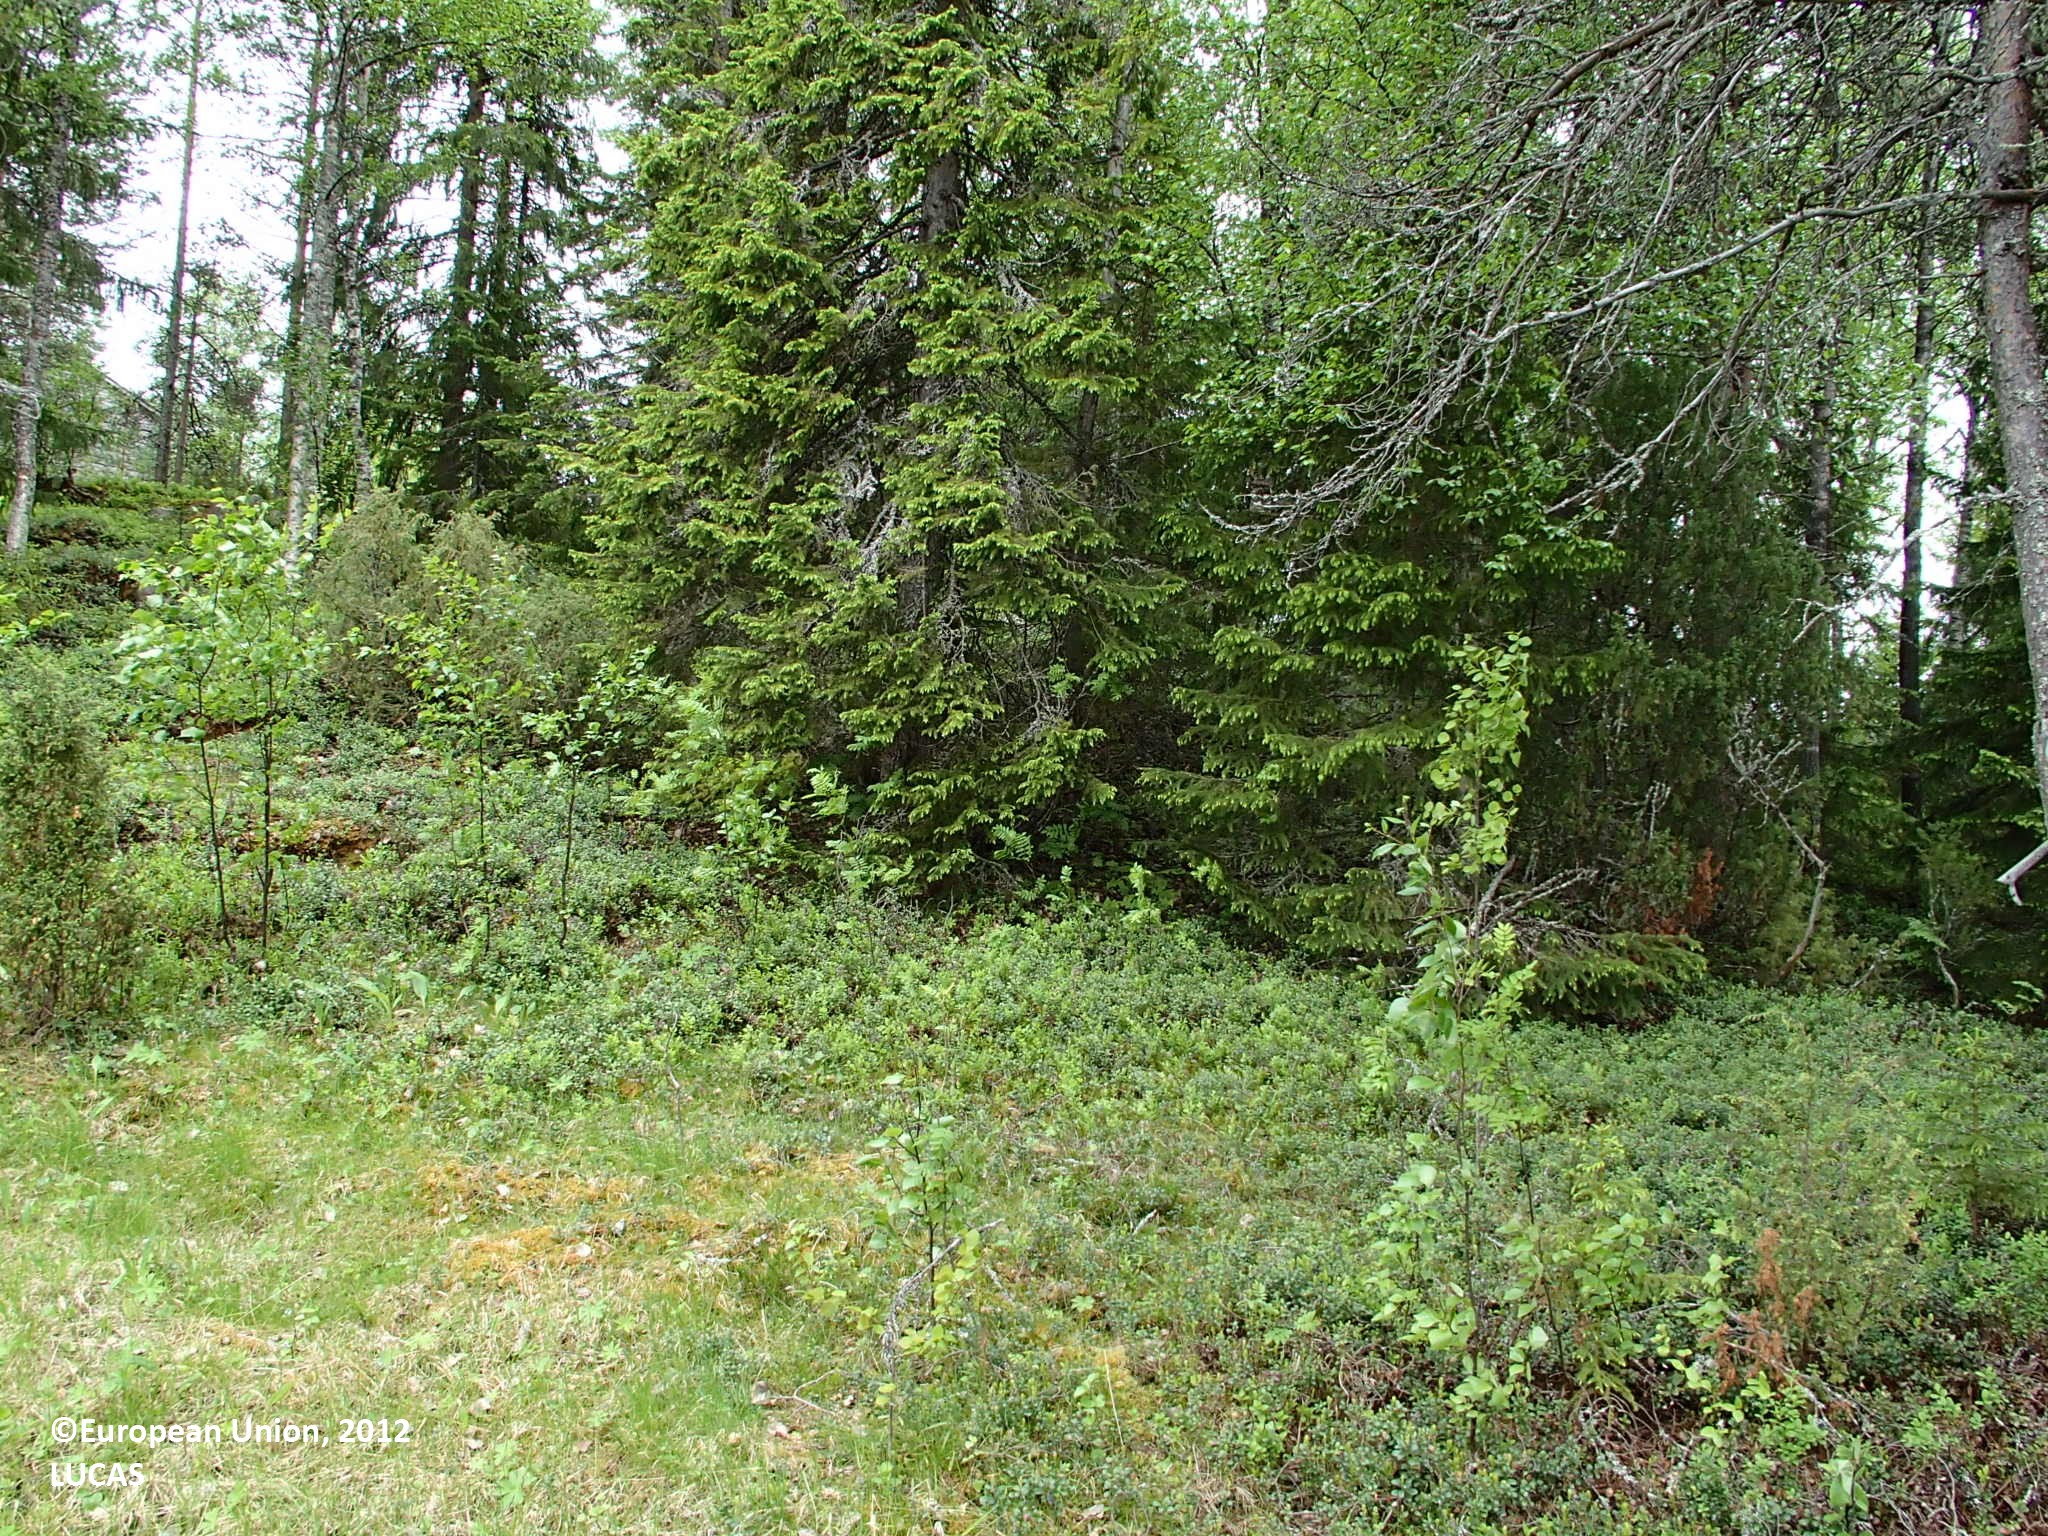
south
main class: Woodland
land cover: Broadleaved woodland
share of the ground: 25 - 50 %
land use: Forestry
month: June
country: FI
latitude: 66.4736
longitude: 27.2828
